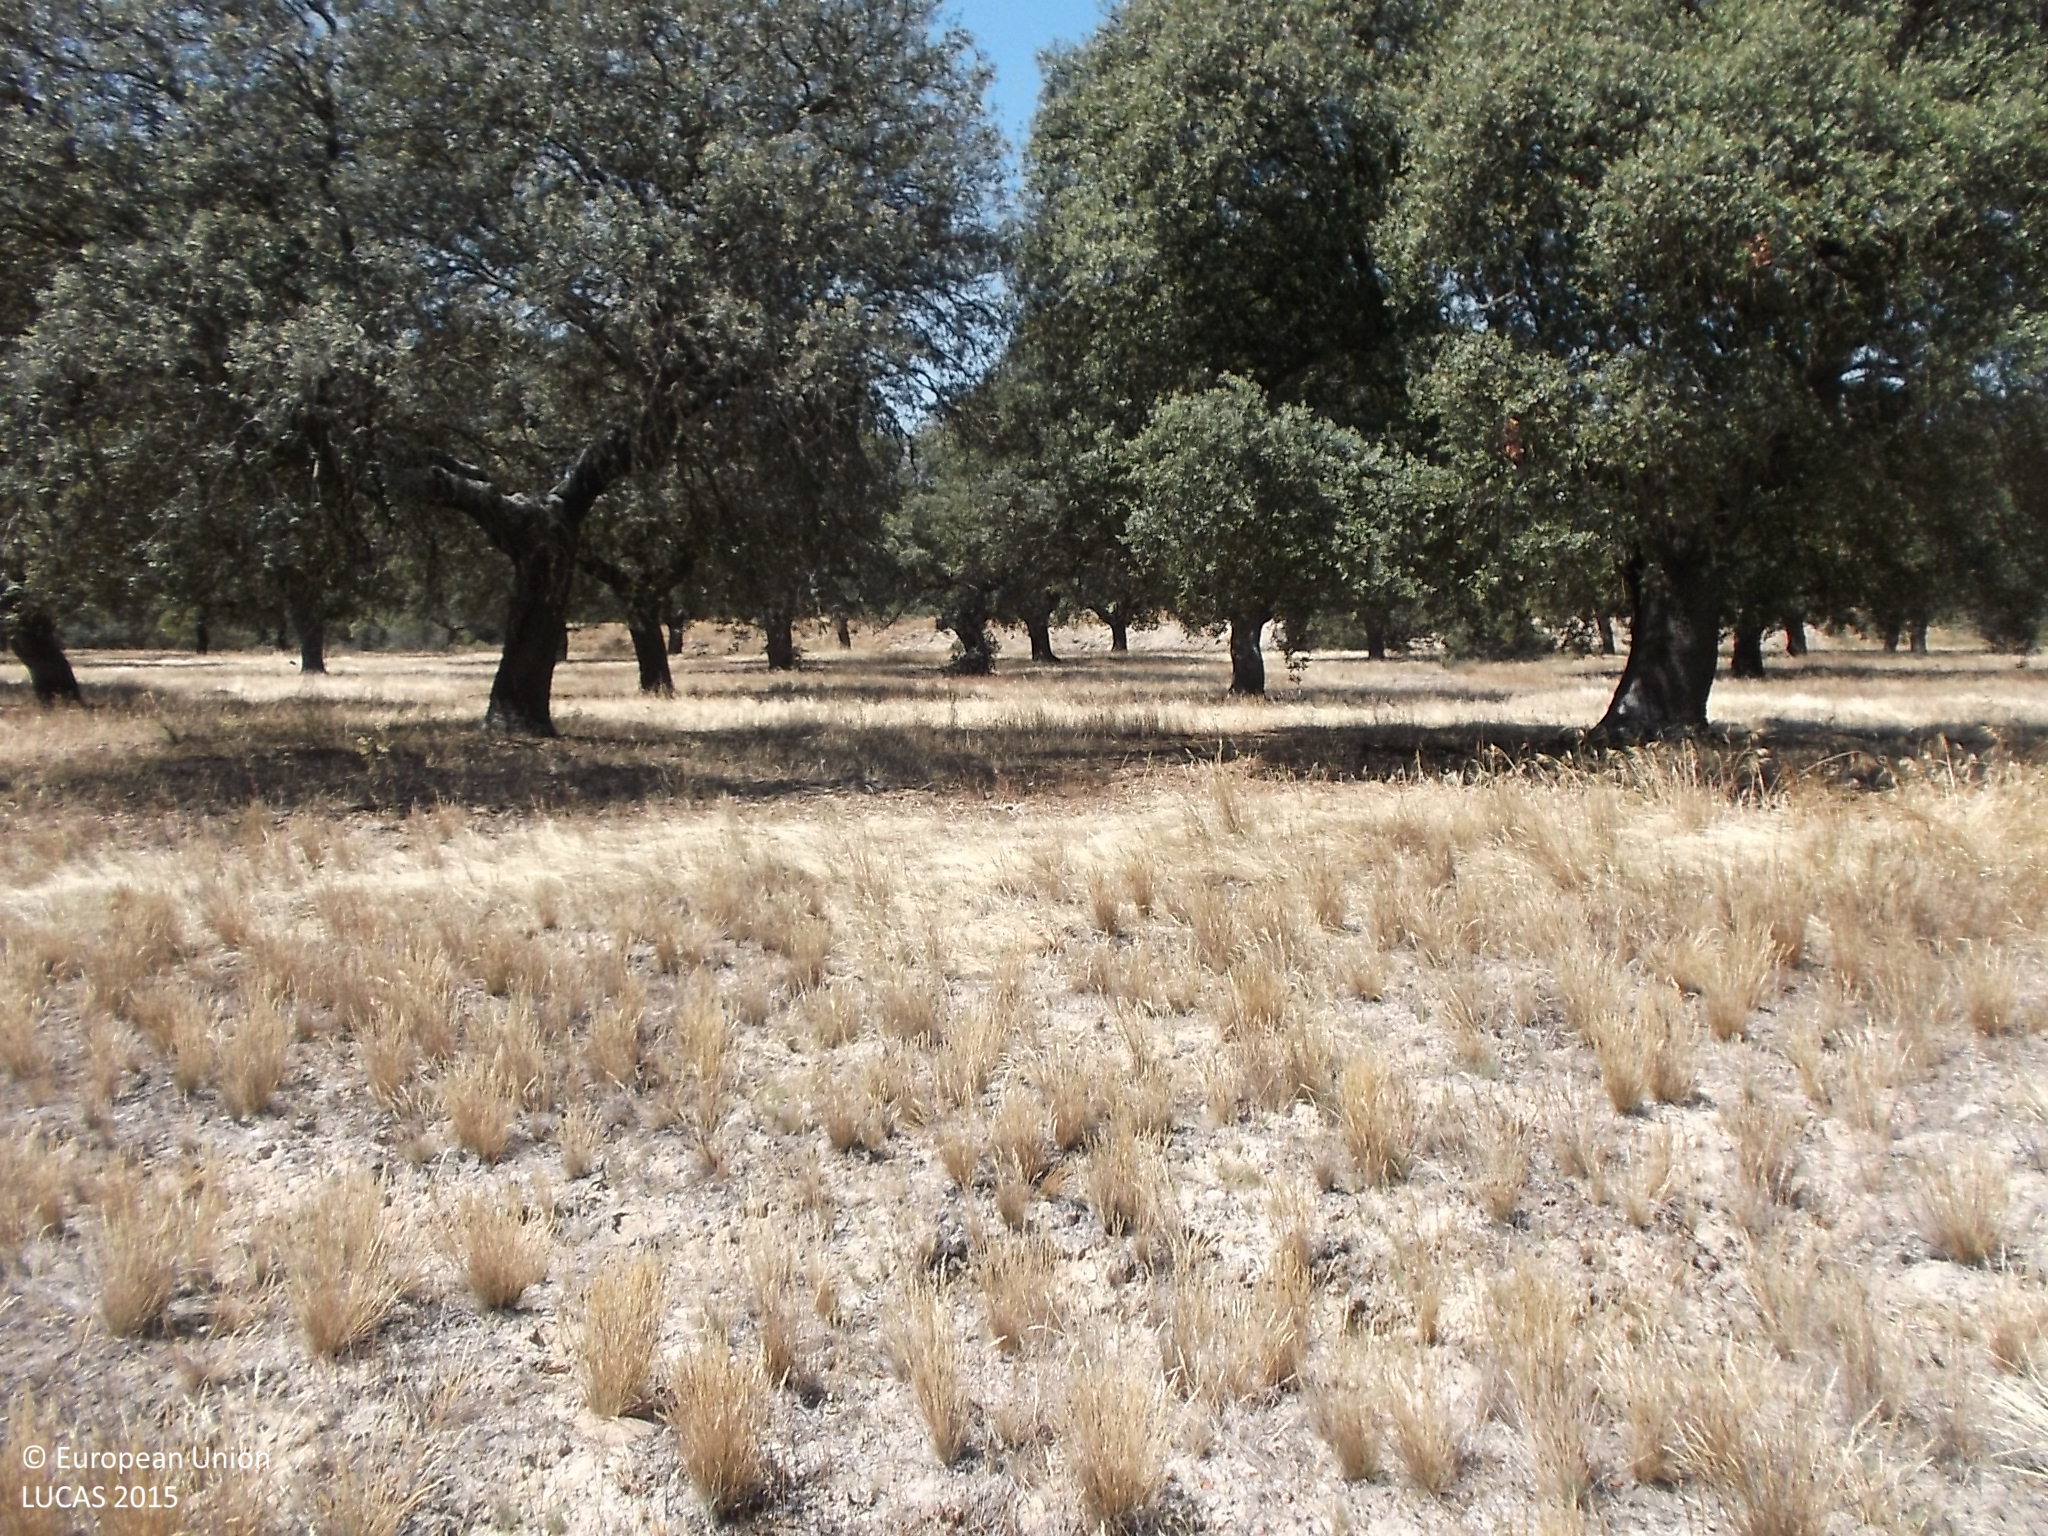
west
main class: Woodland
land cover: Broadleaved woodland
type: broadleaved evergreen forest
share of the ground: 50 - 75 %
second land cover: Grassland without tree/shrub cover
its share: 50 - 75 %
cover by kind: broadleaved forest trees 50 %, herbaceous plants 50 %
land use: Forestry
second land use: Agriculture (excluding fallow land and kitchen gardens)
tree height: < 5 m
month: July
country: ES
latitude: 41.3670
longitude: -5.8067
